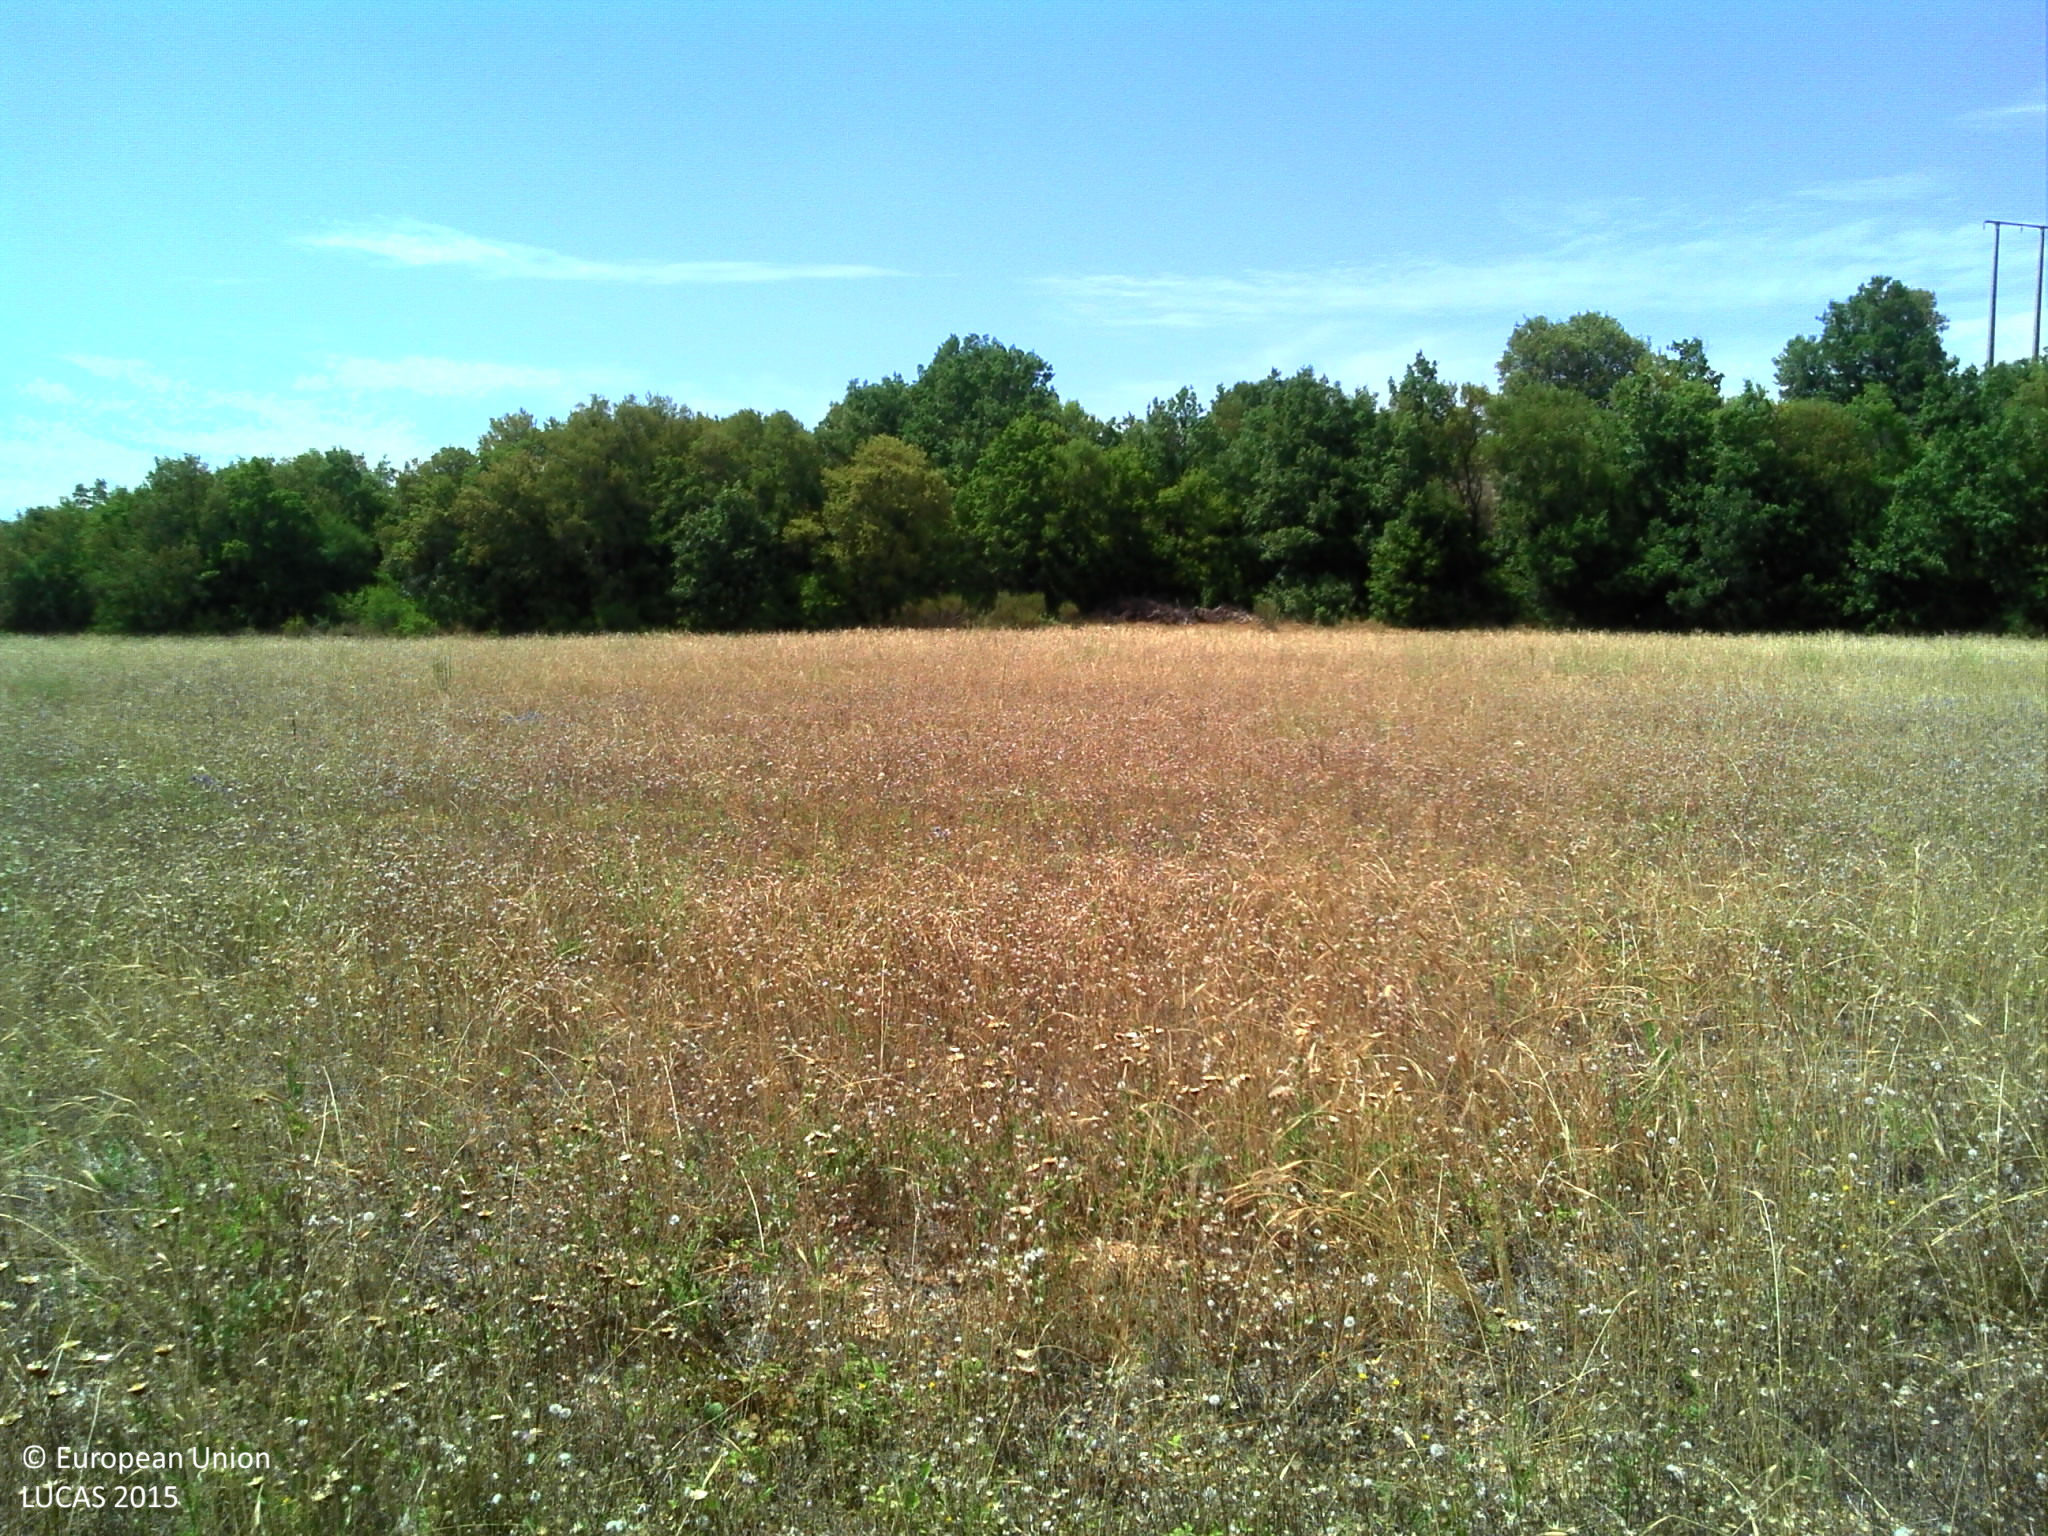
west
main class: Cropland
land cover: Barley
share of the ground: > 75 %
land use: Agriculture (excluding fallow land and kitchen gardens)
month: July
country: FR
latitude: 44.0882
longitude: 5.4495
